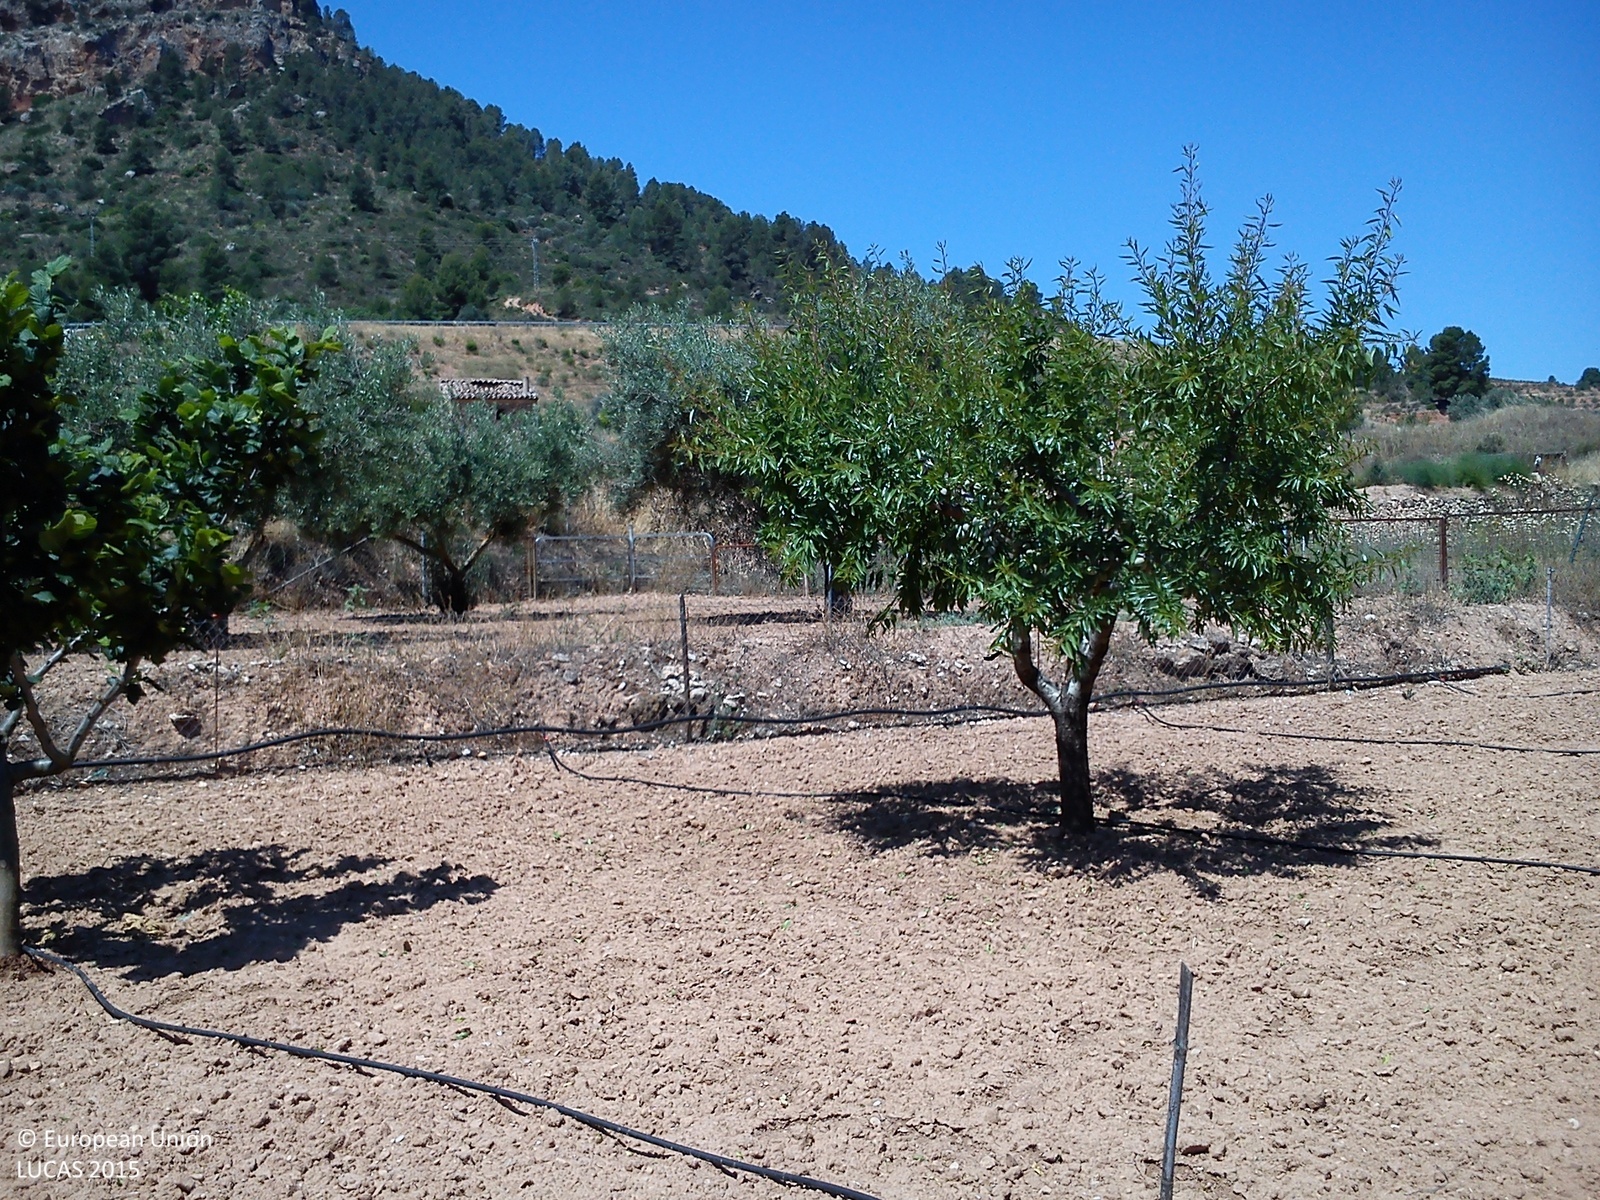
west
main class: Cropland
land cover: Cherry fruit
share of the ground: 10 - 25 %
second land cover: Other bare soil
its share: > 75 %
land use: Agriculture (excluding fallow land and kitchen gardens)
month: June
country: ES
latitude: 39.2203
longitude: -1.0595
